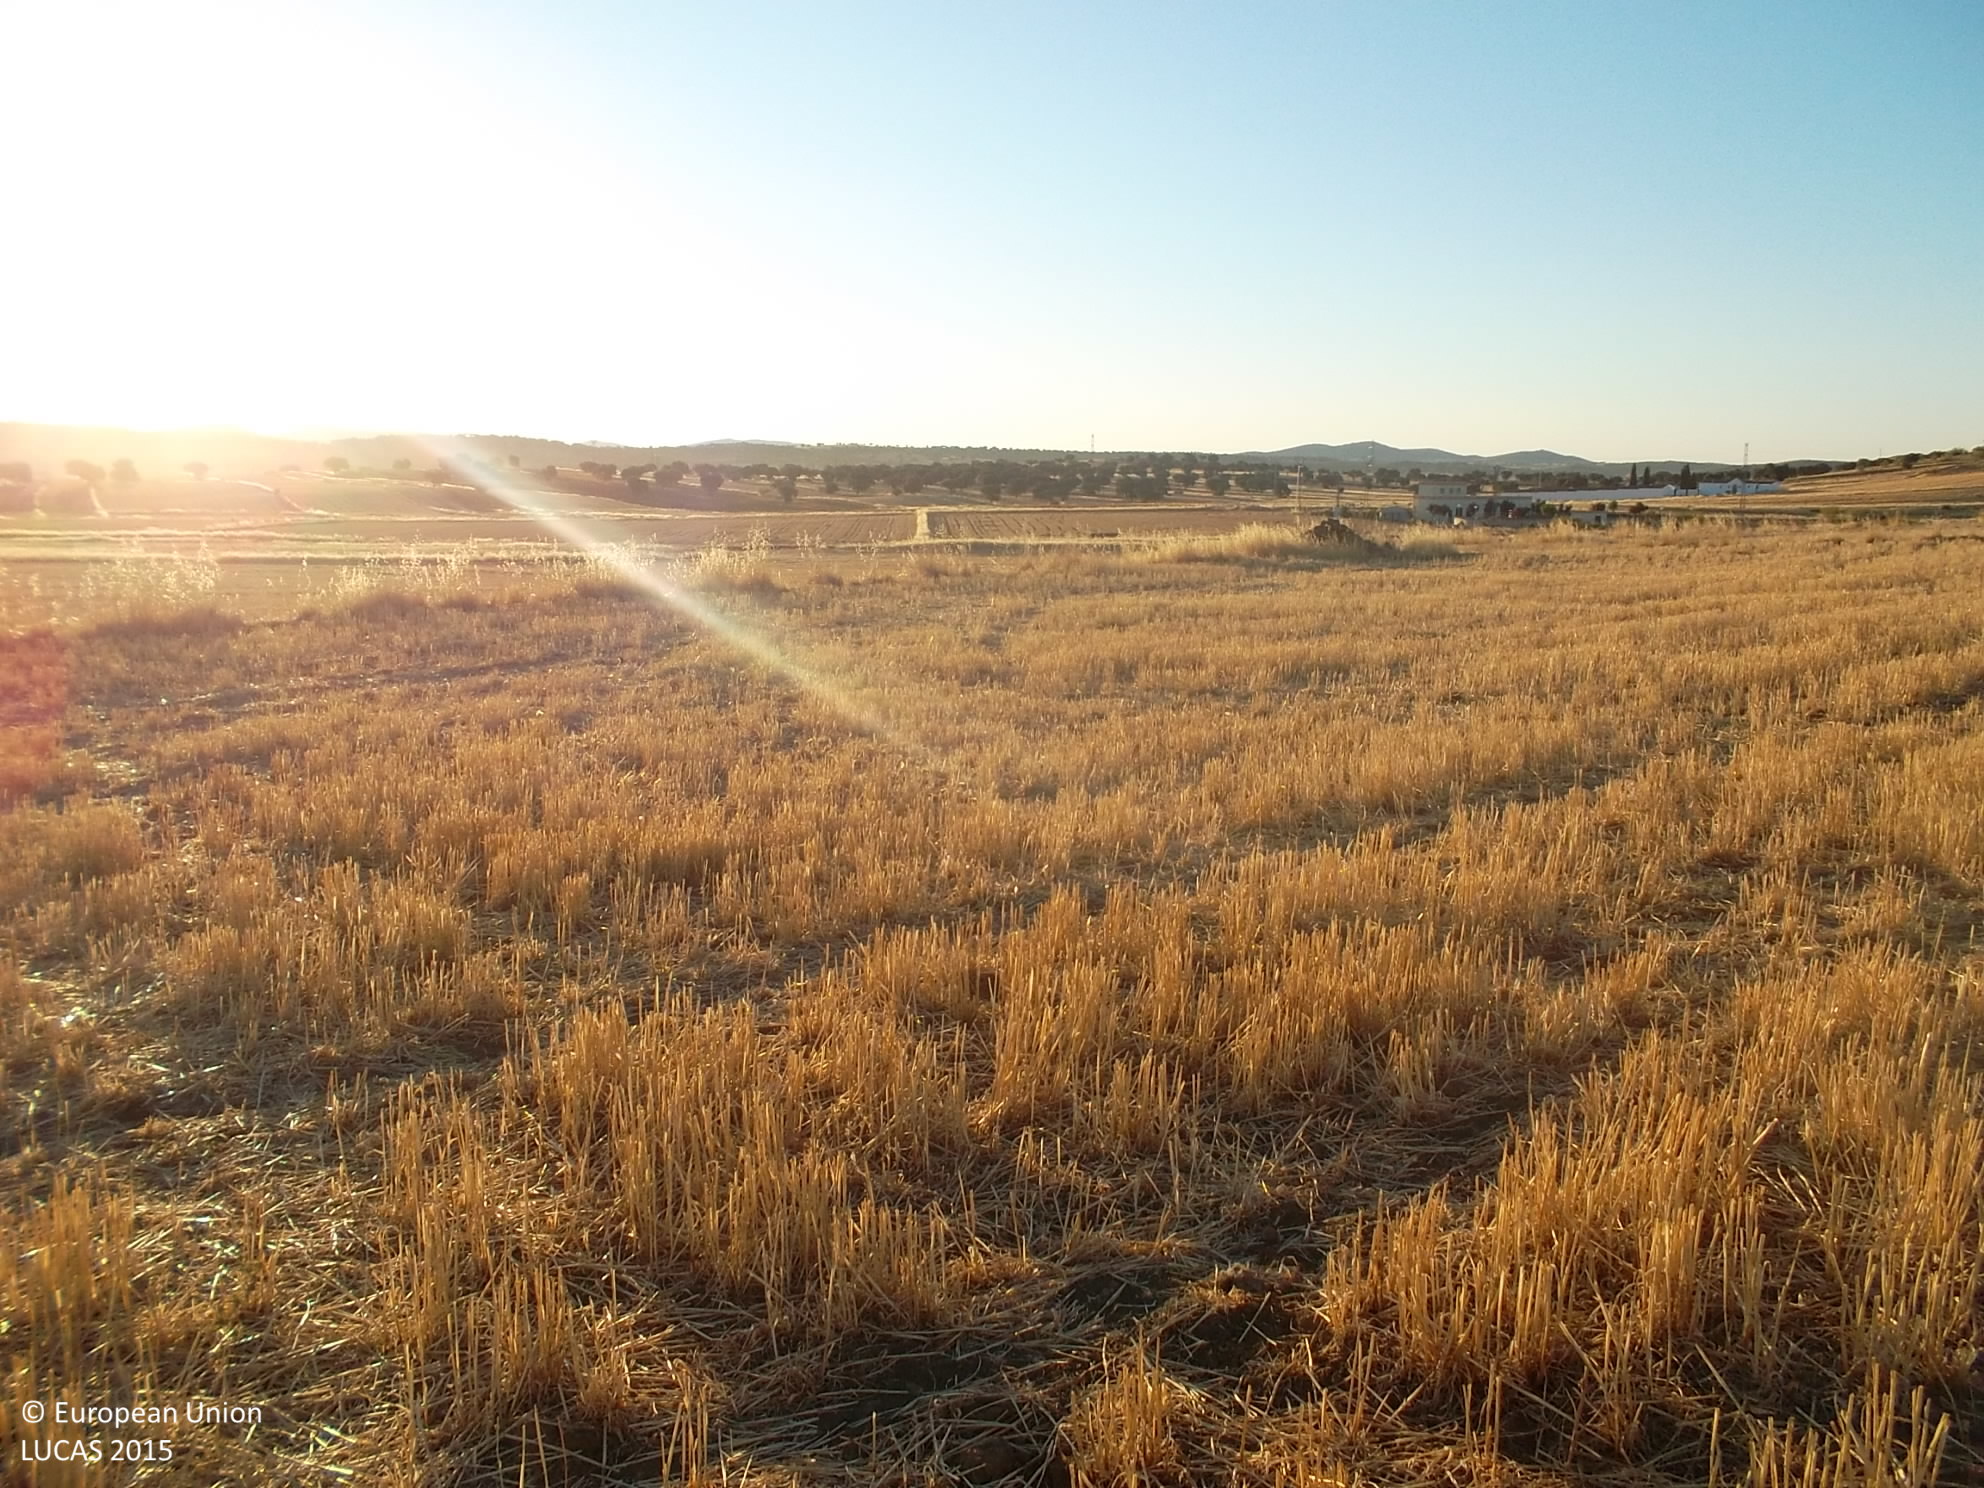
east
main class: Cropland
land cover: Oats
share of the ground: < 10 %
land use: Agriculture (excluding fallow land and kitchen gardens)
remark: Harvested field
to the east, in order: Oats; Grass margins; Oats
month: July
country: ES
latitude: 38.5123
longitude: -5.8331
